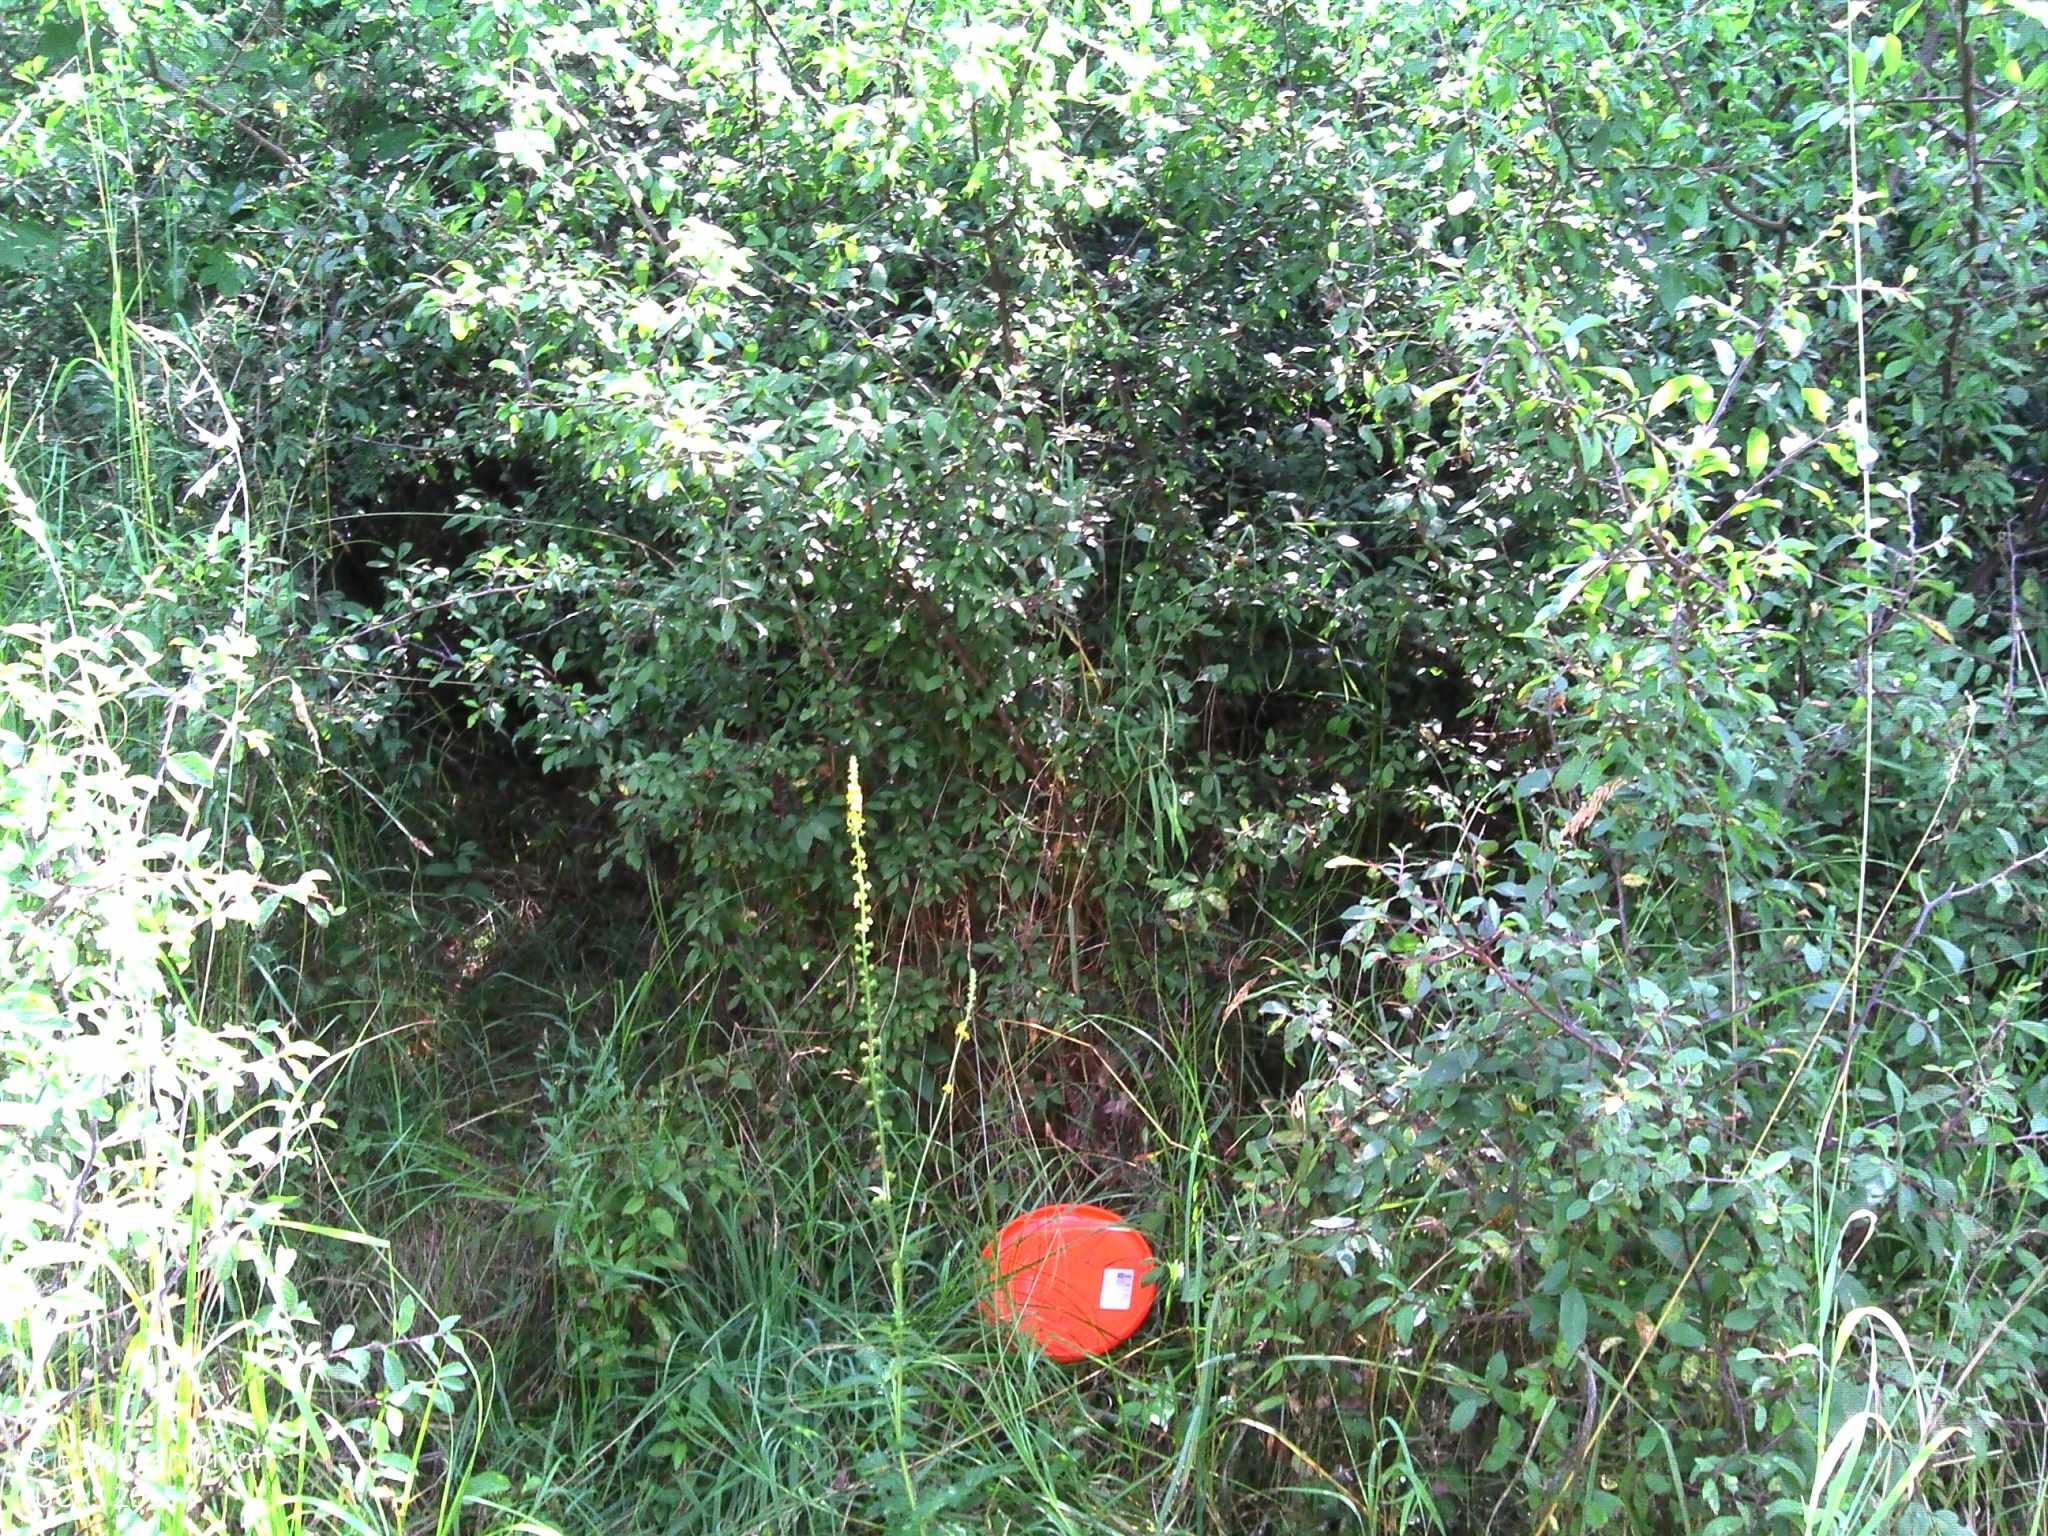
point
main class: Shrubland
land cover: Shrubland with sparse tree cover
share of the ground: 50 - 75 %
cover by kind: shrubs 60 %, herbaceous plants 35 %, broadleaved forest trees 5 %
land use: Forestry
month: July
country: BE
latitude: 49.7286
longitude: 5.7954
